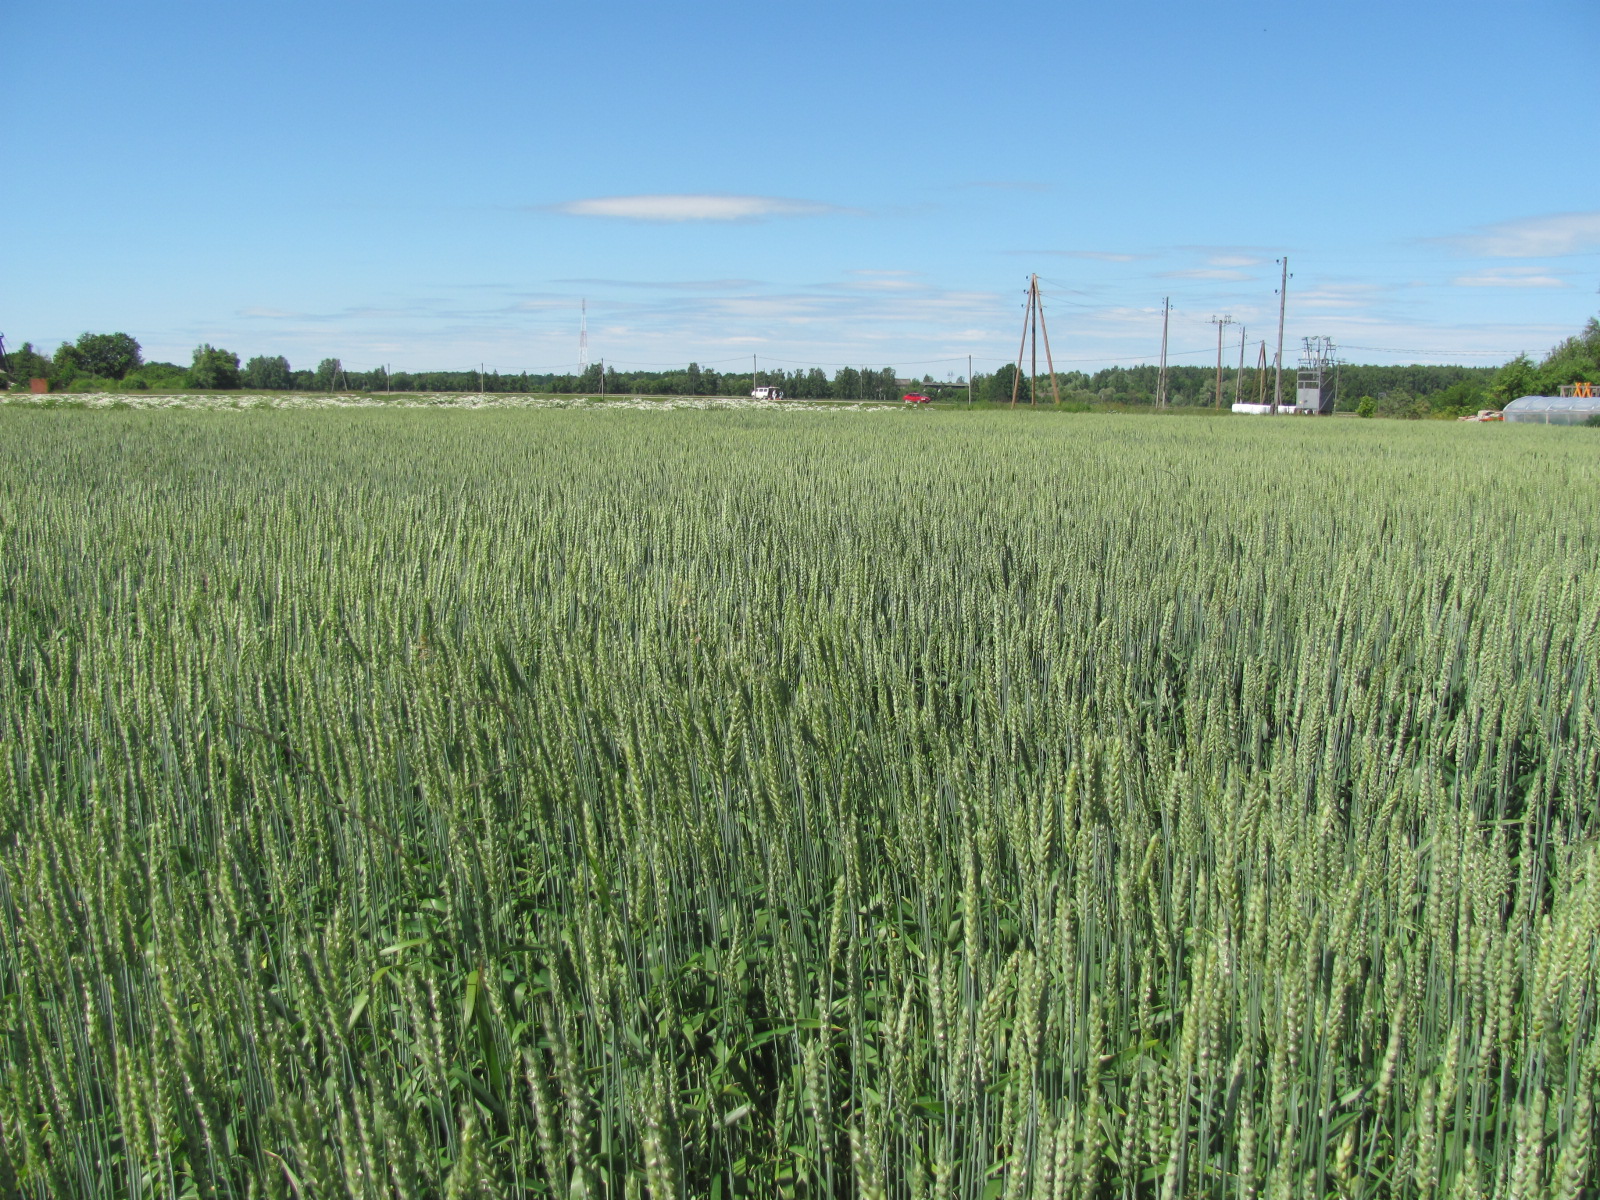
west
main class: Cropland
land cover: Common wheat
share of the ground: > 75 %
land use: Agriculture (excluding fallow land and kitchen gardens)
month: July
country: LV
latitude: 56.5419
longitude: 23.7242
